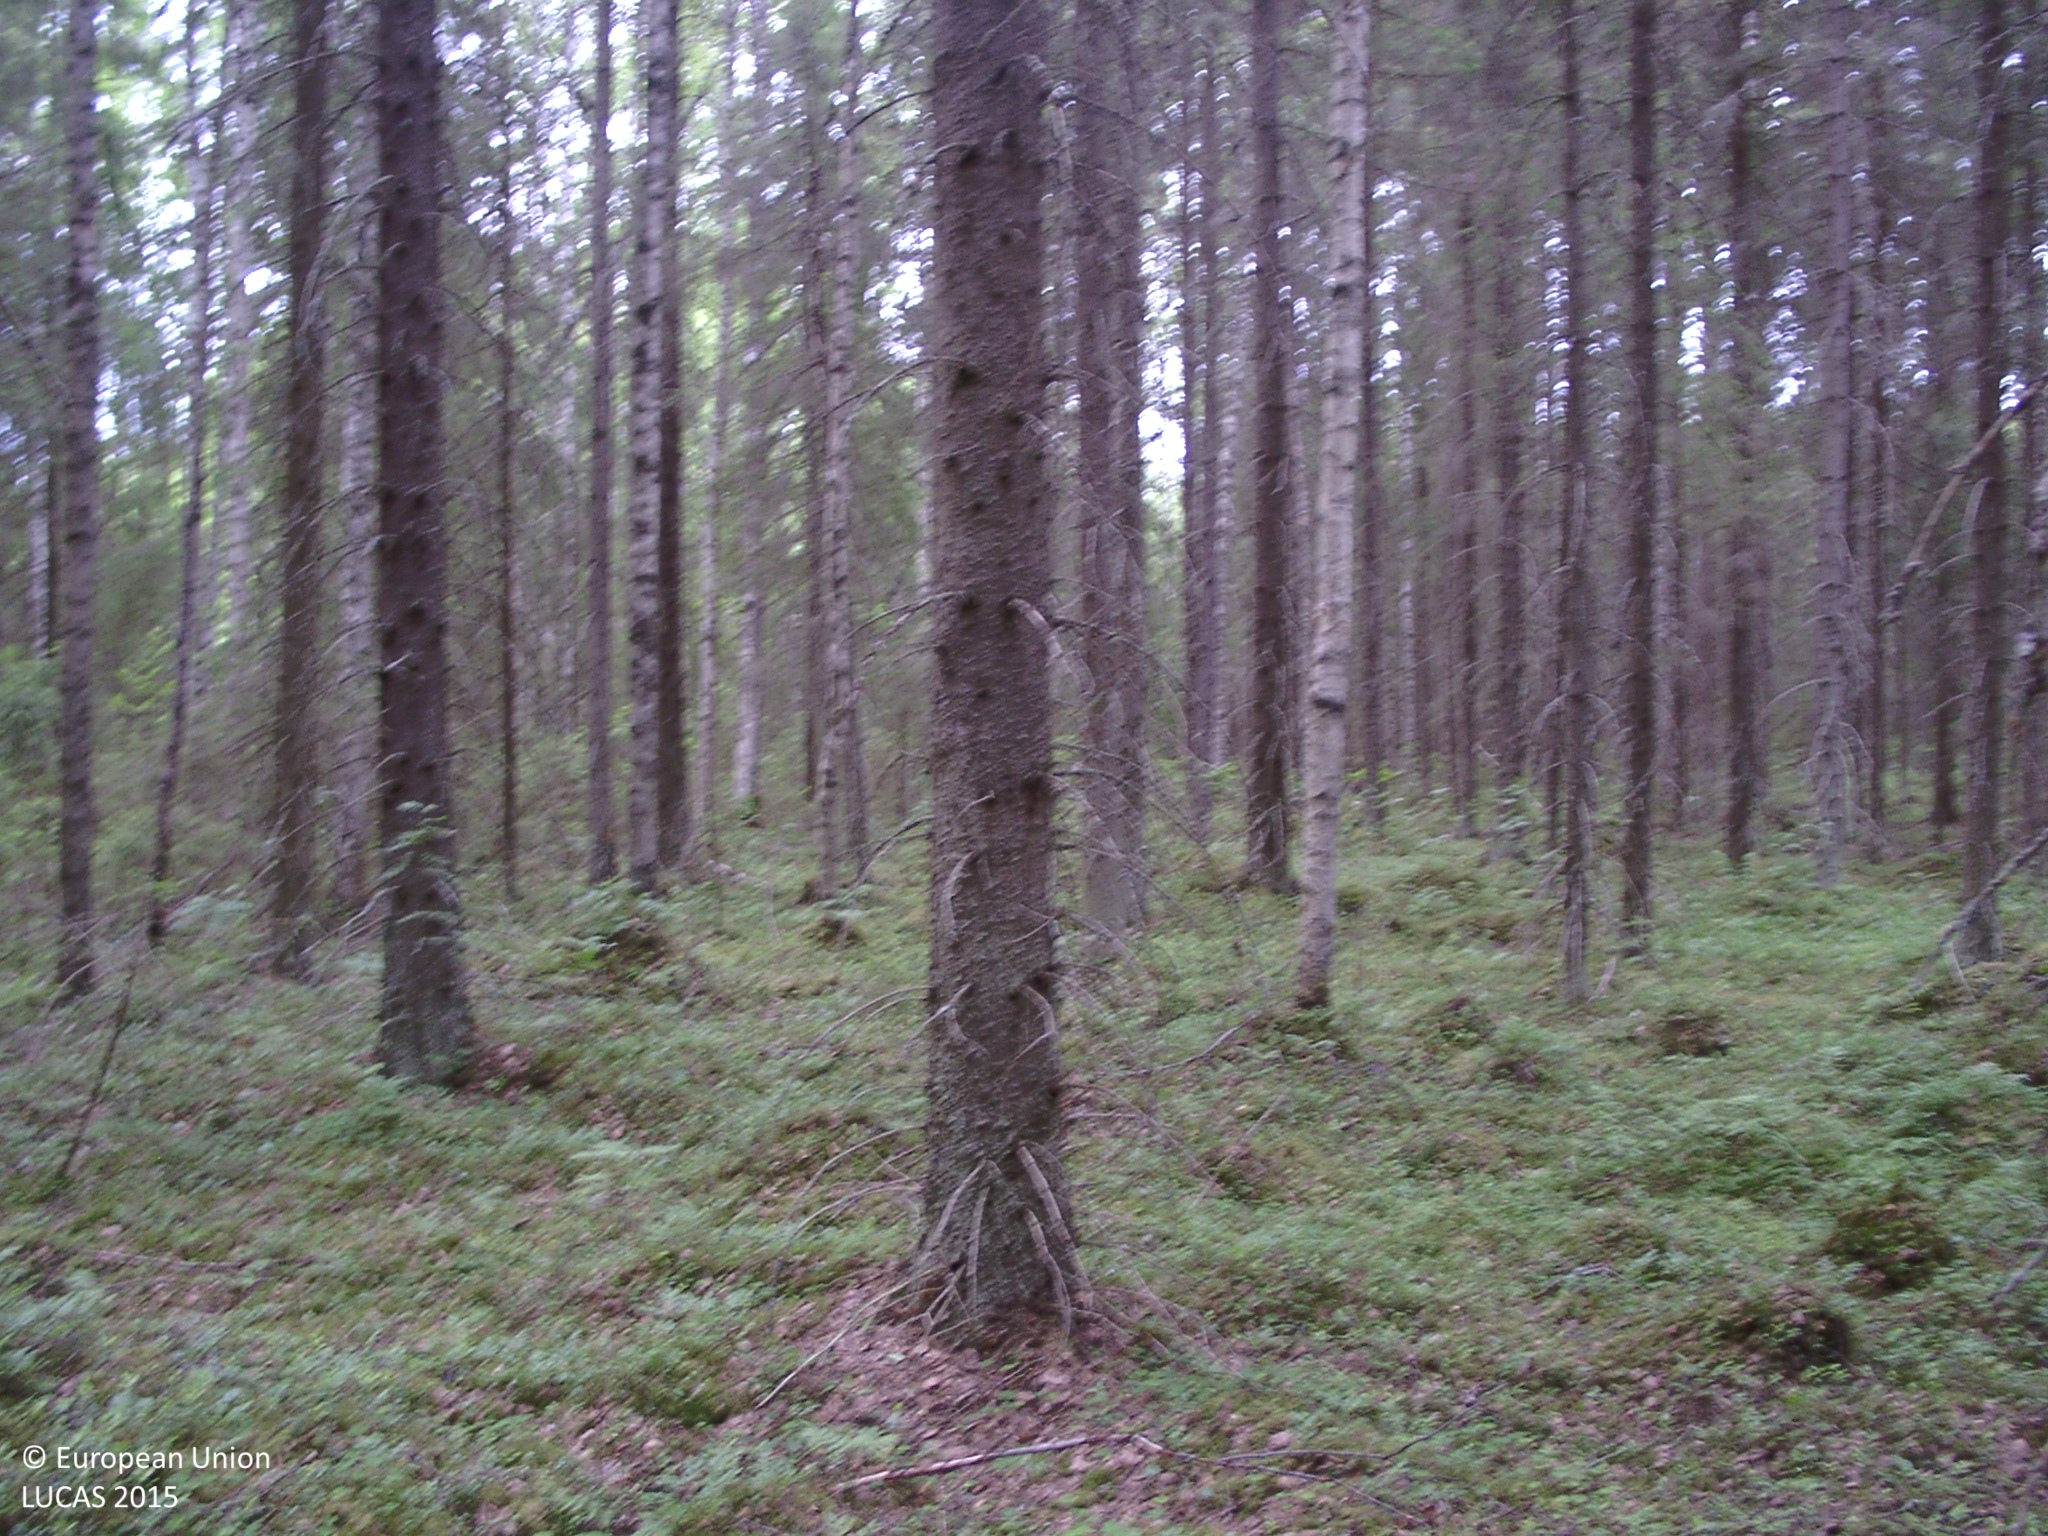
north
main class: Woodland
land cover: Spruce dominated coniferous woodland
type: boreal forest
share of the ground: > 75 %
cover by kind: coniferous forest trees 65 %, broadleaved forest trees 15 %, lichens and mosses 10 %, shrubs 5 %, herbaceous plants 5 %
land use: Semi-natural and natural areas not in use
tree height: > 5 m
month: June
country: FI
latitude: 62.0451
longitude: 25.1180
